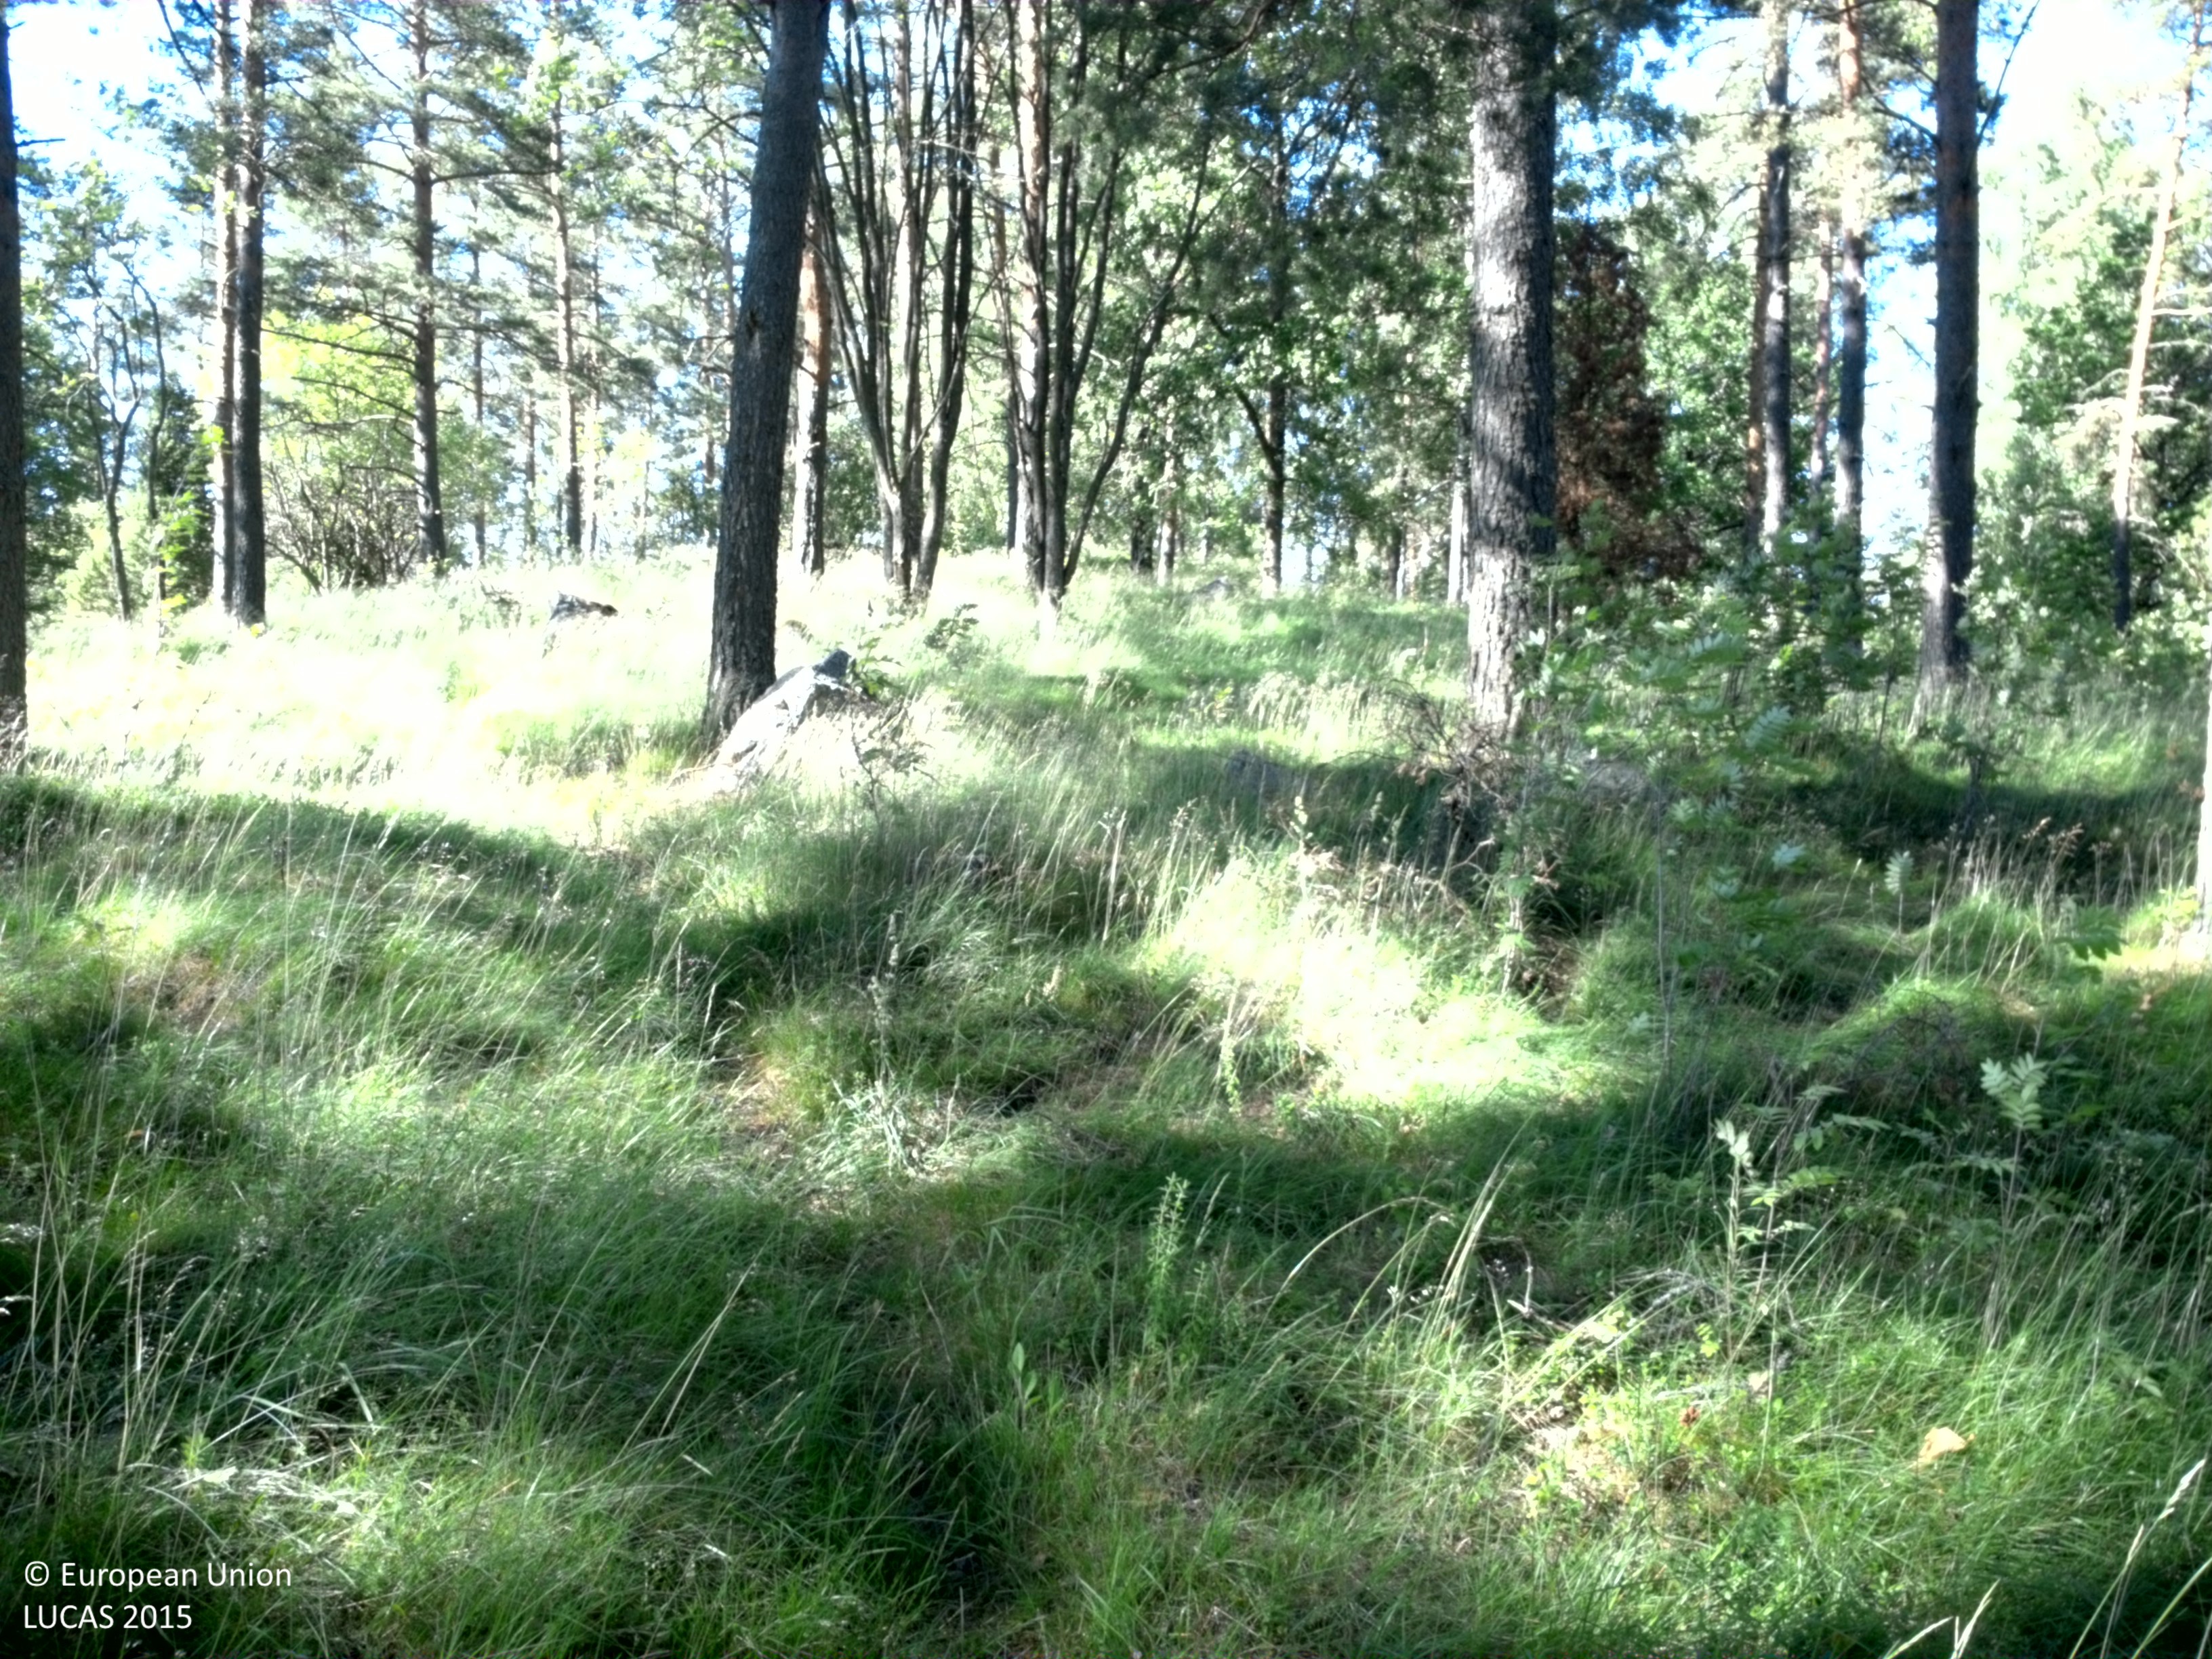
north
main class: Woodland
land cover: Pine dominated coniferous woodland
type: boreal forest
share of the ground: 50 - 75 %
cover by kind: coniferous forest trees 50 %, herbaceous plants 45 %, broadleaved forest trees 5 %
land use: Forestry
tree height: > 5 m
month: July
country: SE
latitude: 59.7436
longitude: 18.4859
